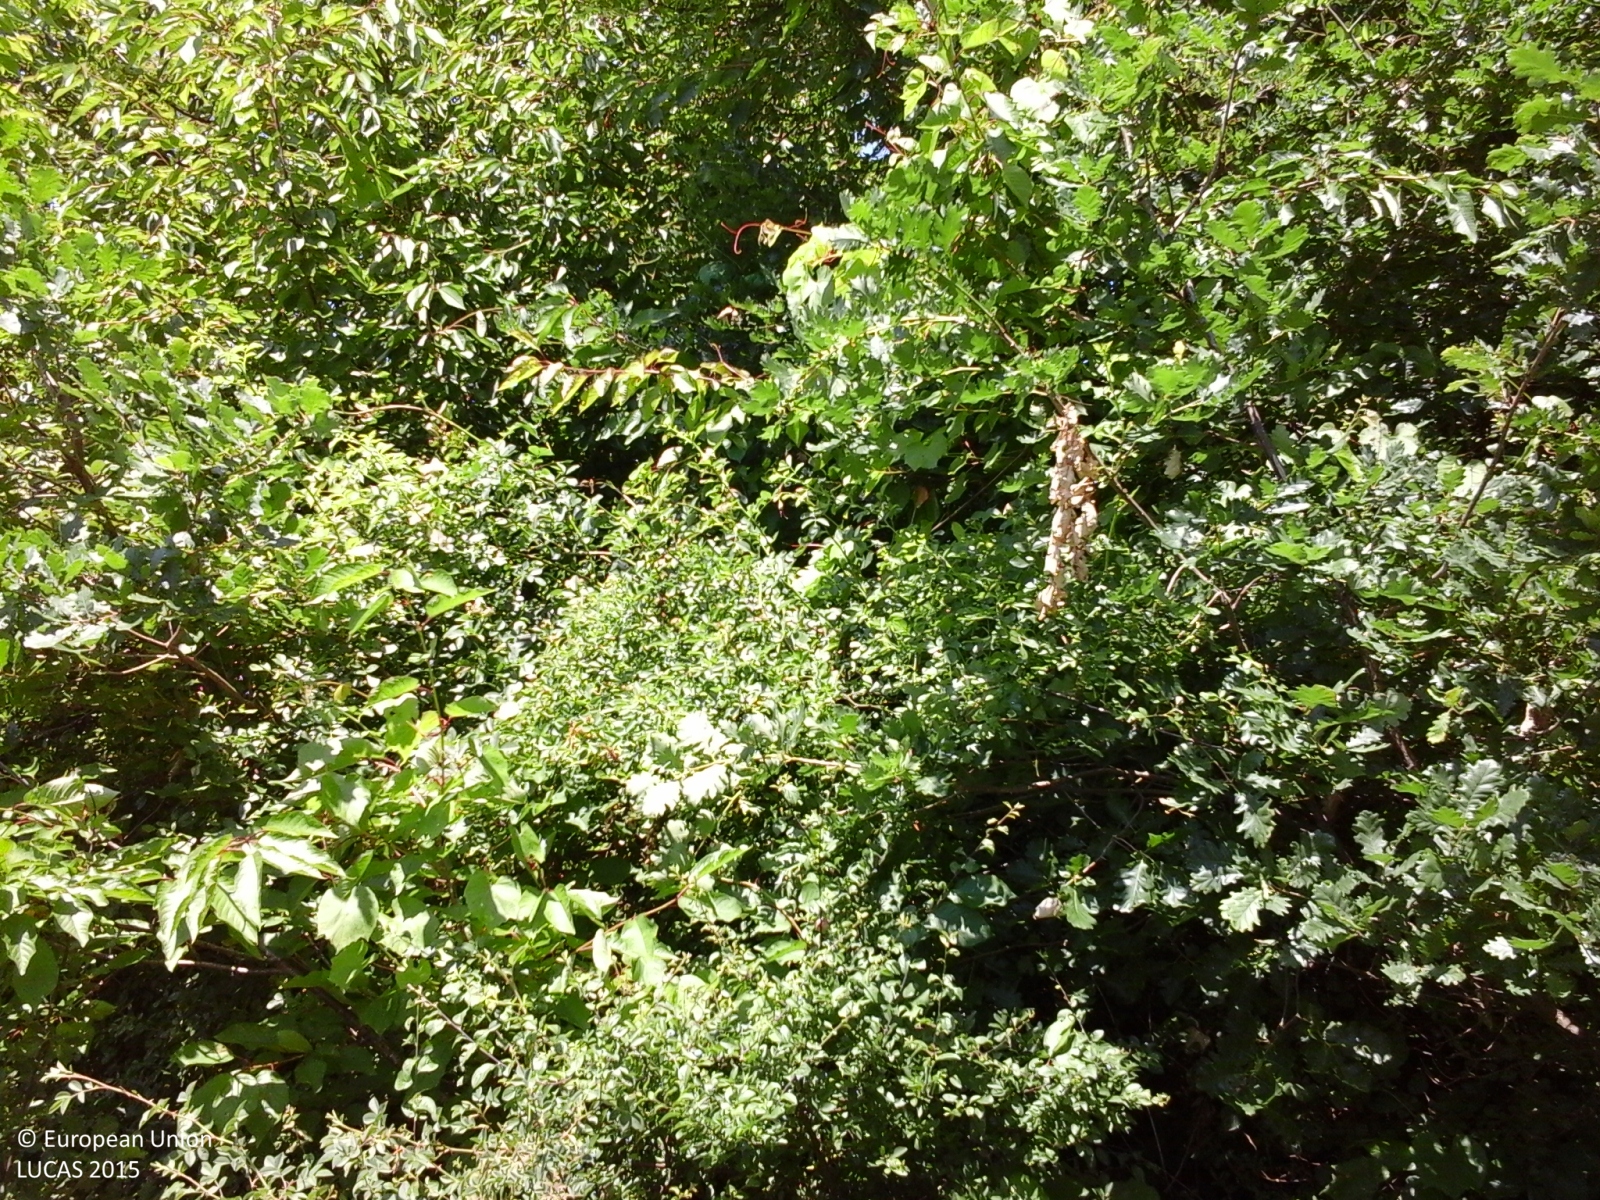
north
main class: Woodland
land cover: Broadleaved woodland
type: mesophytic deciduous forest
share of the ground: > 75 %
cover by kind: broadleaved forest trees 80 %, shrubs 10 %, herbaceous plants 10 %
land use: Forestry
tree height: > 5 m
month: June
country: IT
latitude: 44.6429
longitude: 8.2763
